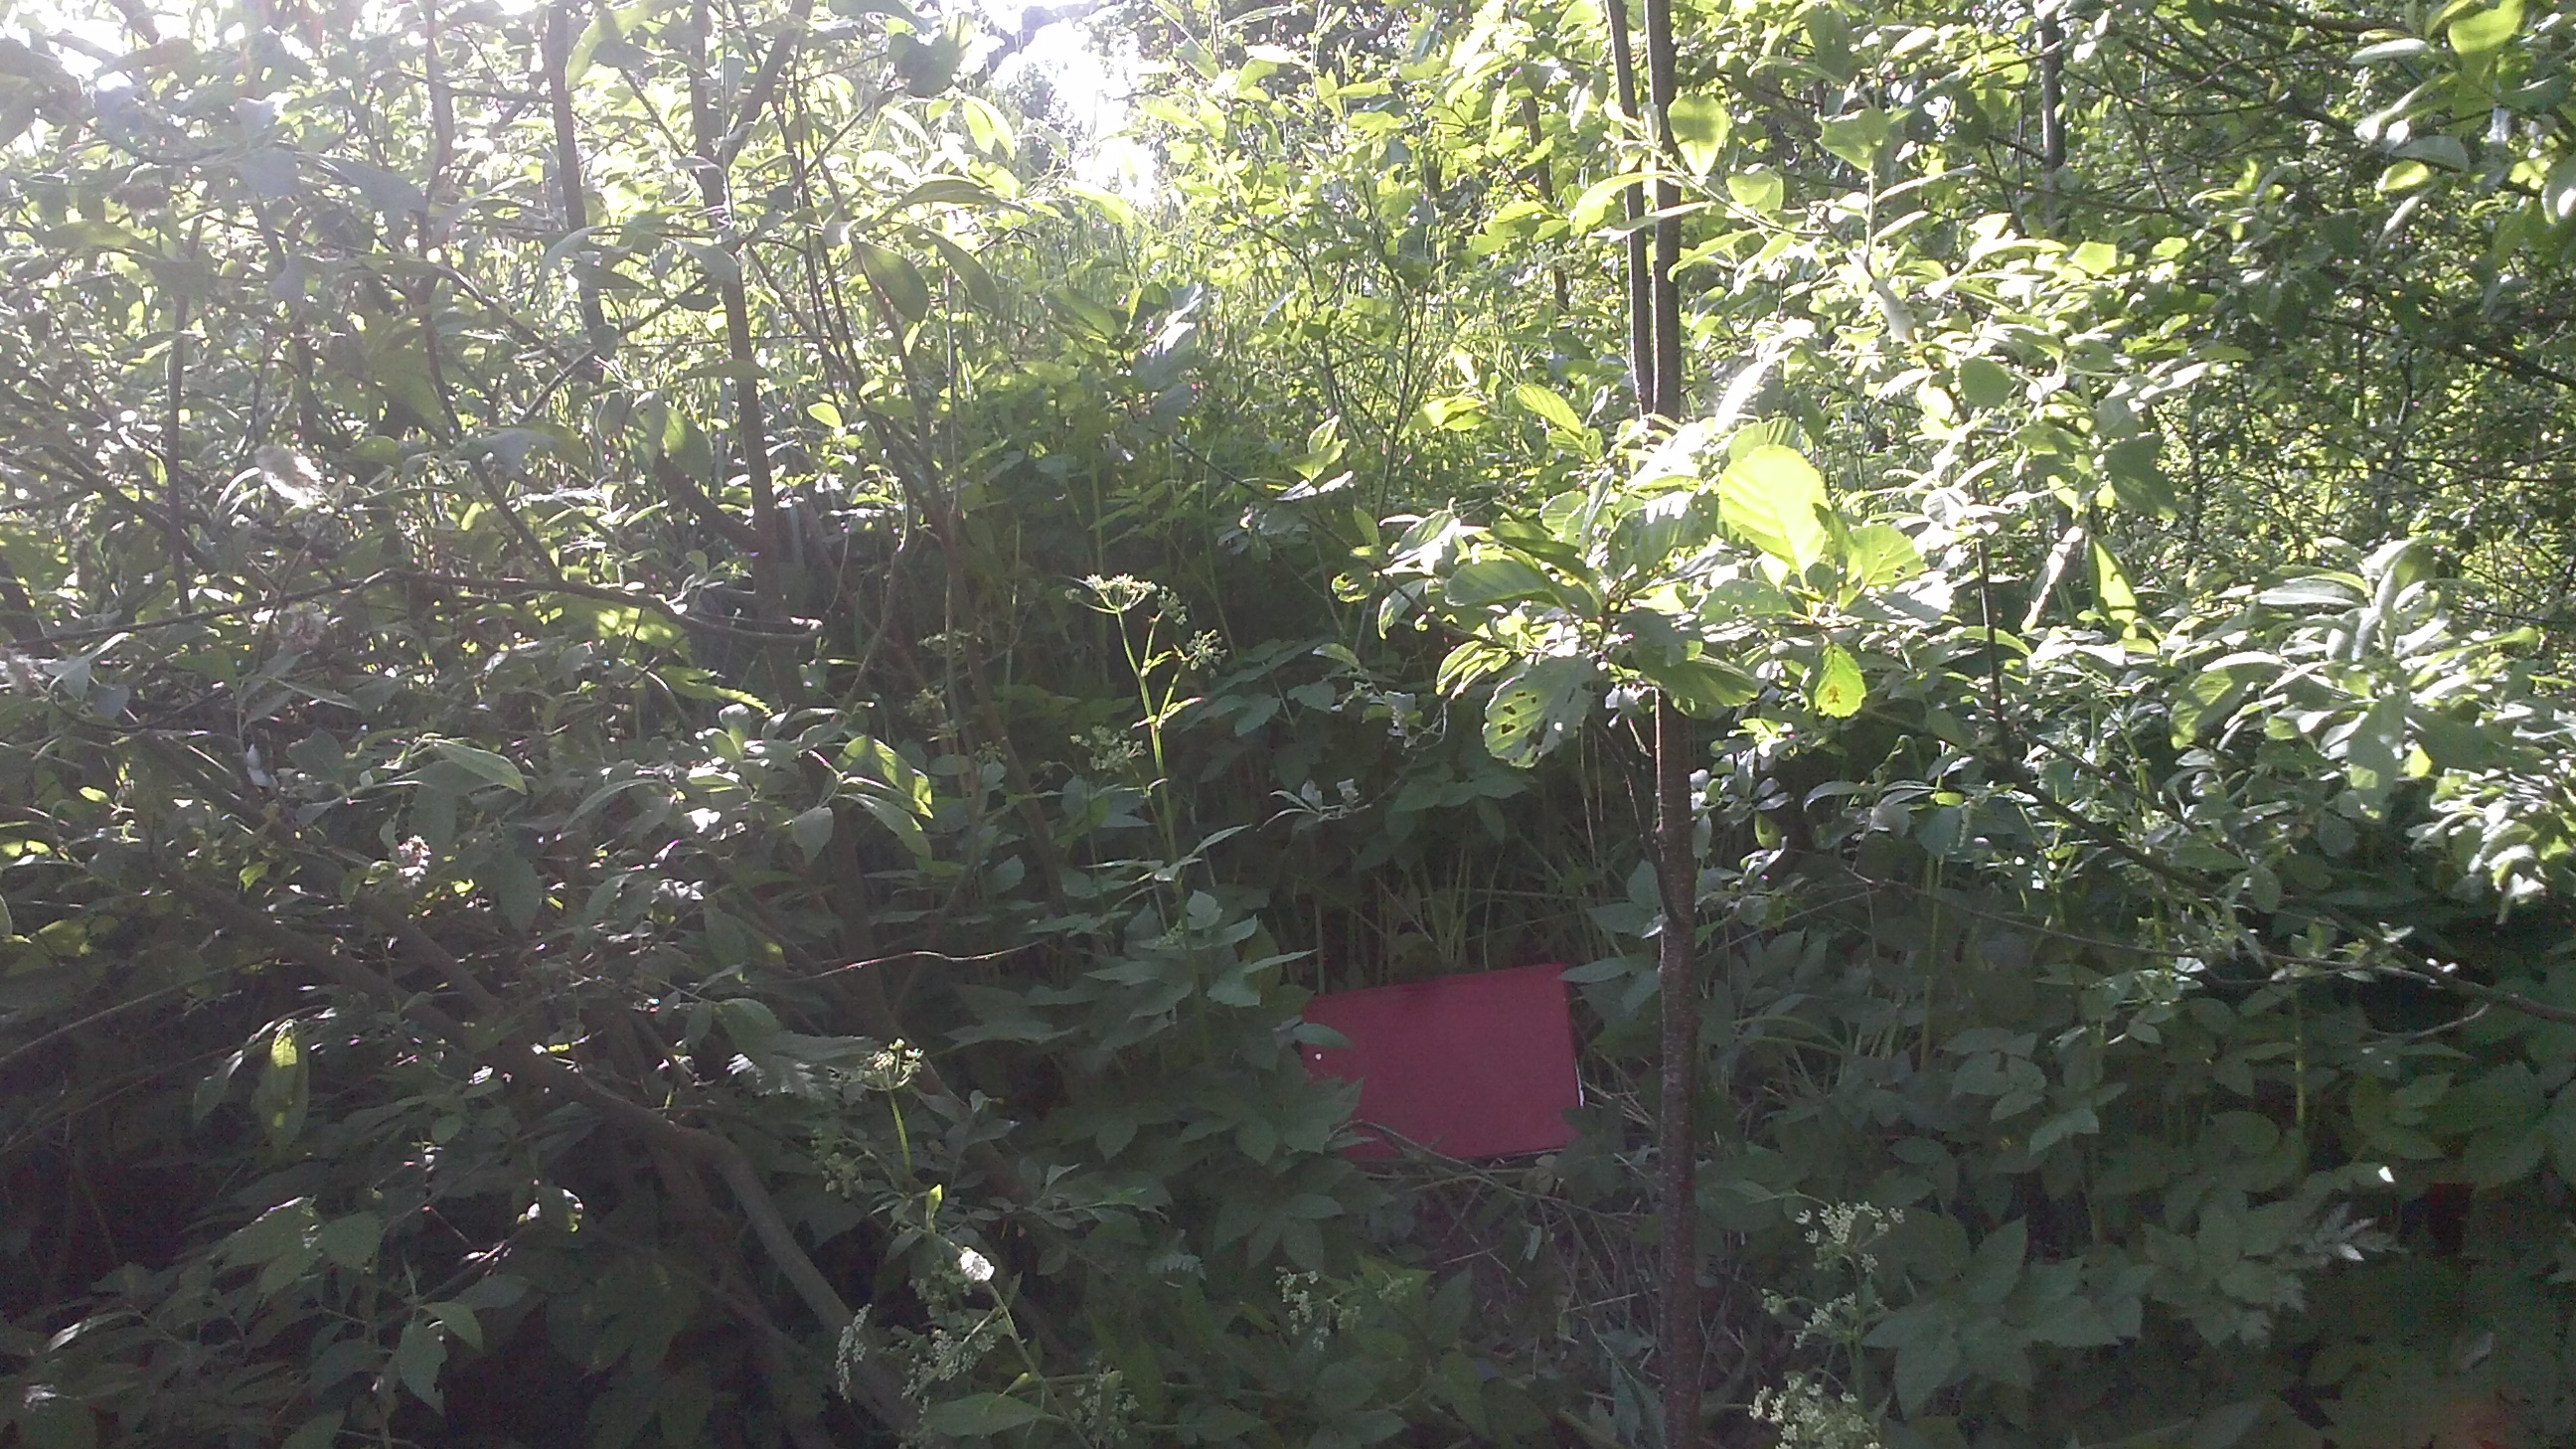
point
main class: Woodland
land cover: Broadleaved woodland
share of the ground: > 75 %
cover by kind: broadleaved forest trees 80 %, shrubs 20 %
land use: Semi-natural and natural areas not in use
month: June
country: LV
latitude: 56.4399
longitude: 27.4184
